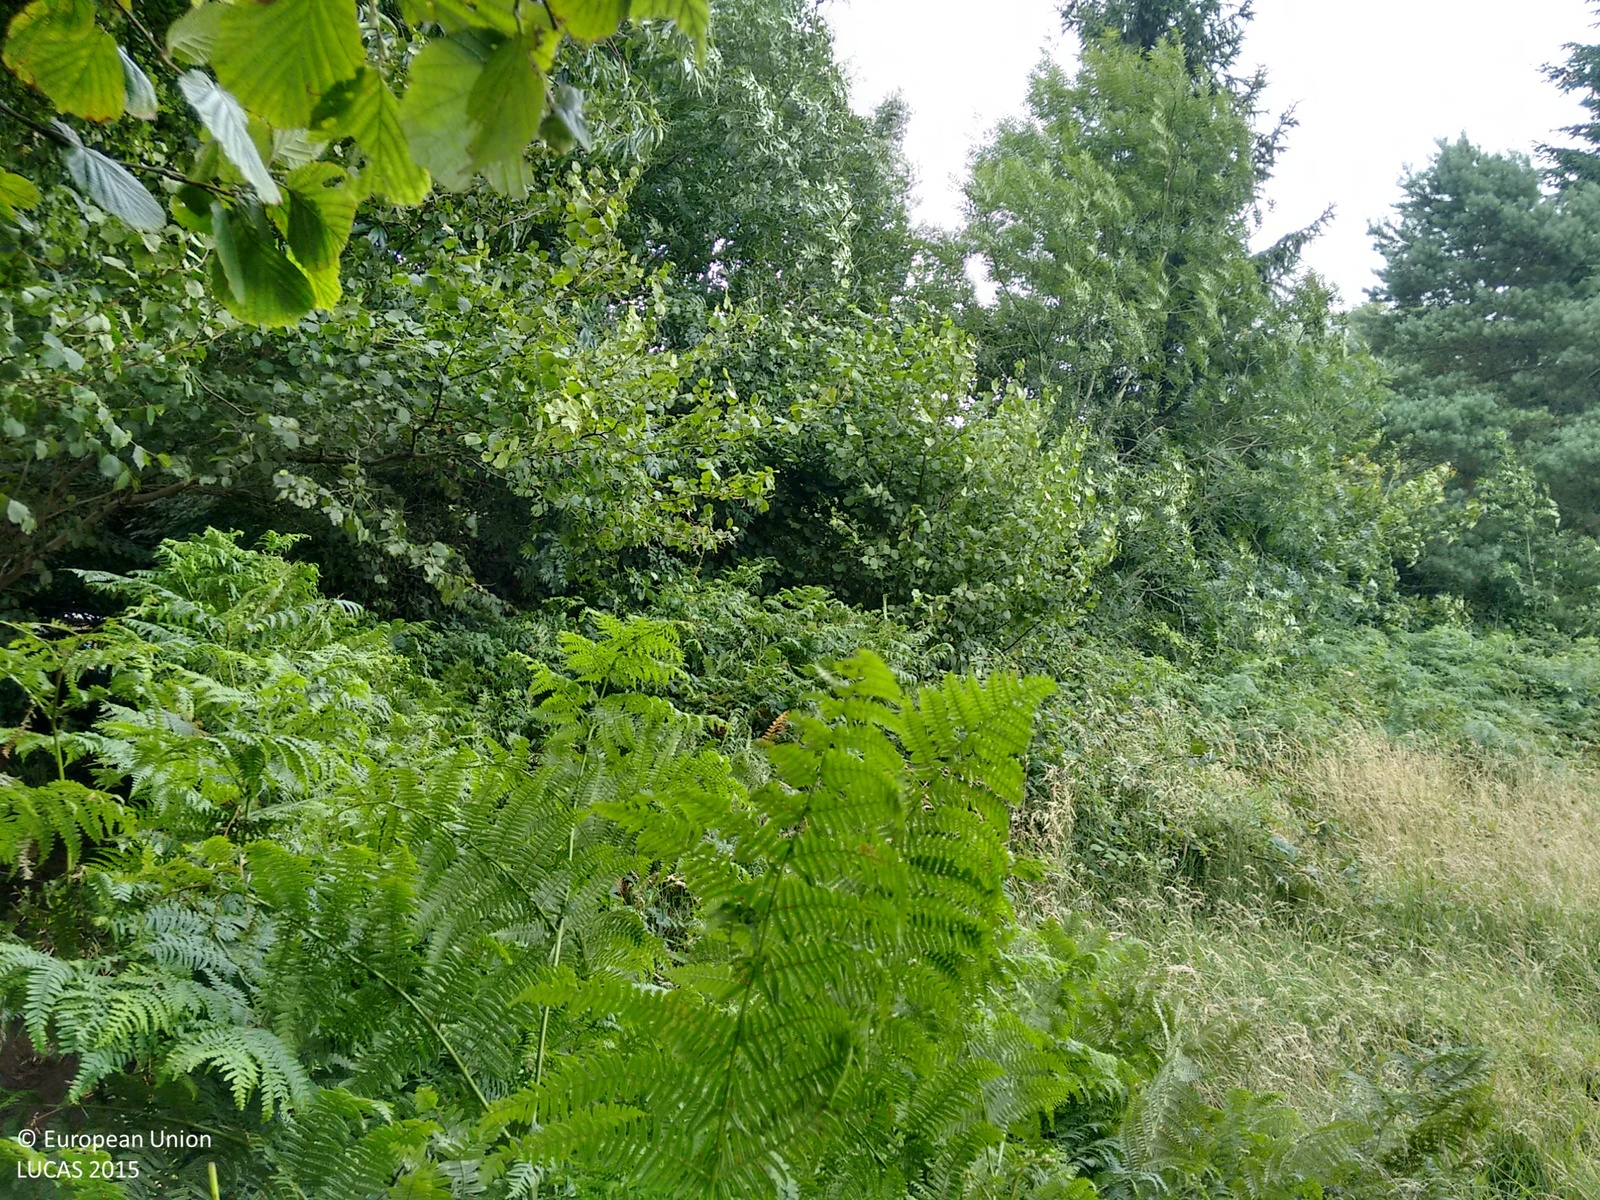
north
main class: Woodland
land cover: Broadleaved woodland
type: mesophytic deciduous forest
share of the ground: > 75 %
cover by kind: broadleaved forest trees 75 %, shrubs 25 %
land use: Forestry
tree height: > 5 m
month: August
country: GB
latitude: 51.2741
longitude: -0.1112
